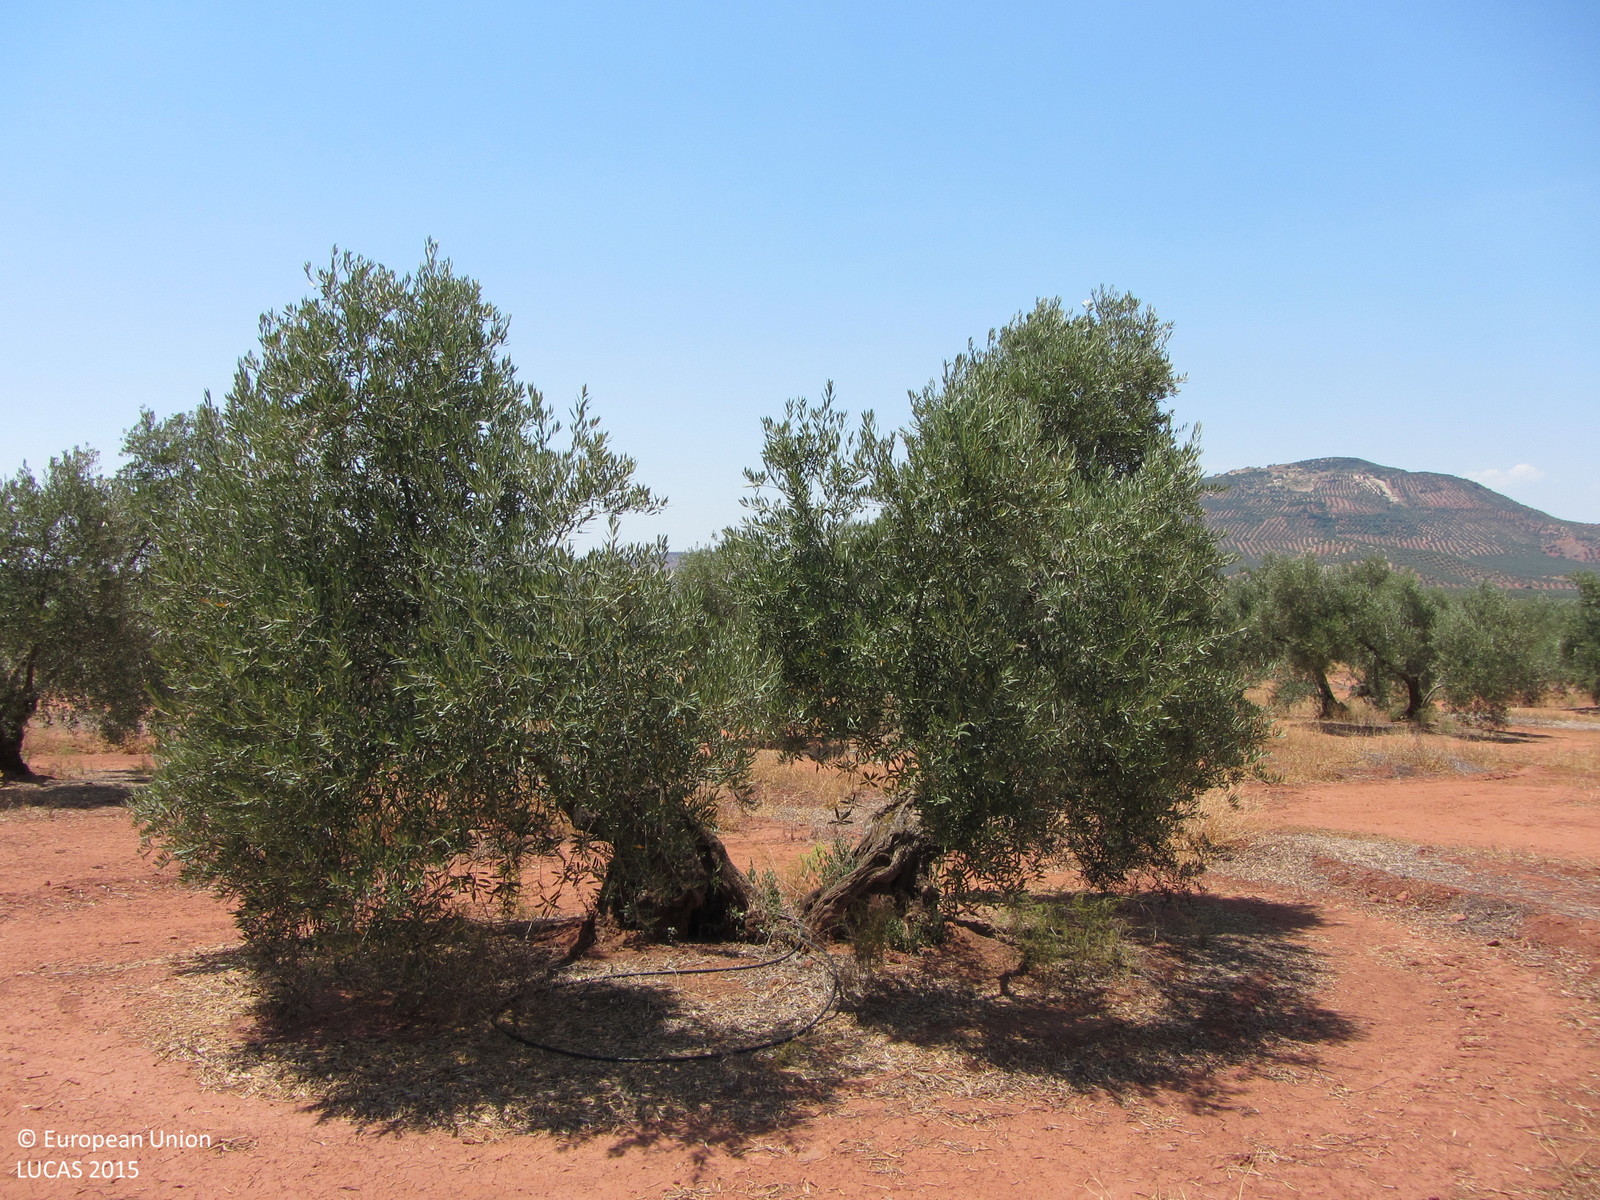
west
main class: Cropland
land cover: Olive groves
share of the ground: 25 - 50 %
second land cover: Other bare soil
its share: > 75 %
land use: Agriculture (excluding fallow land and kitchen gardens)
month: June
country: ES
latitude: 38.2011
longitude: -3.4440
